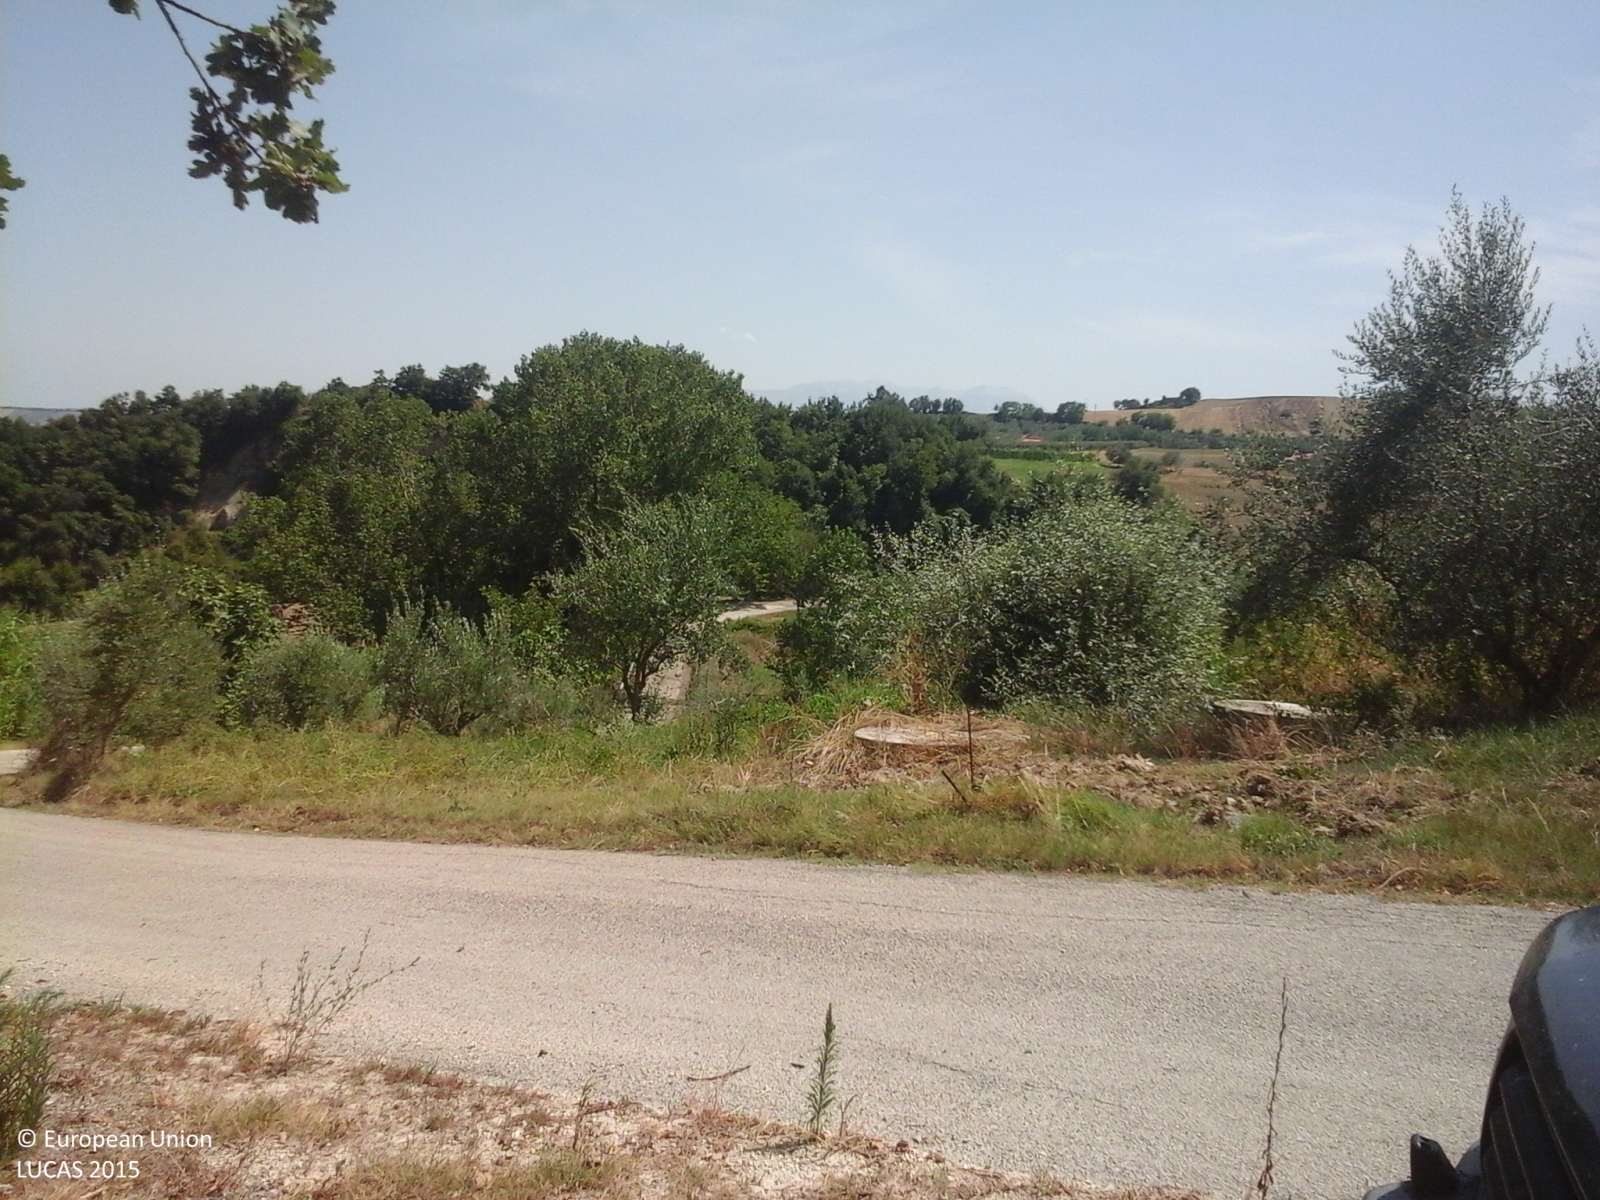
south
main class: Woodland
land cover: Broadleaved woodland
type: thermophilous deciduous forest
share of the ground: > 75 %
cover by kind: broadleaved forest trees 80 %, shrubs 10 %, herbaceous plants 10 %
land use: Semi-natural and natural areas not in use
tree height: > 5 m
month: August
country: IT
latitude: 42.4337
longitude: 13.9144
